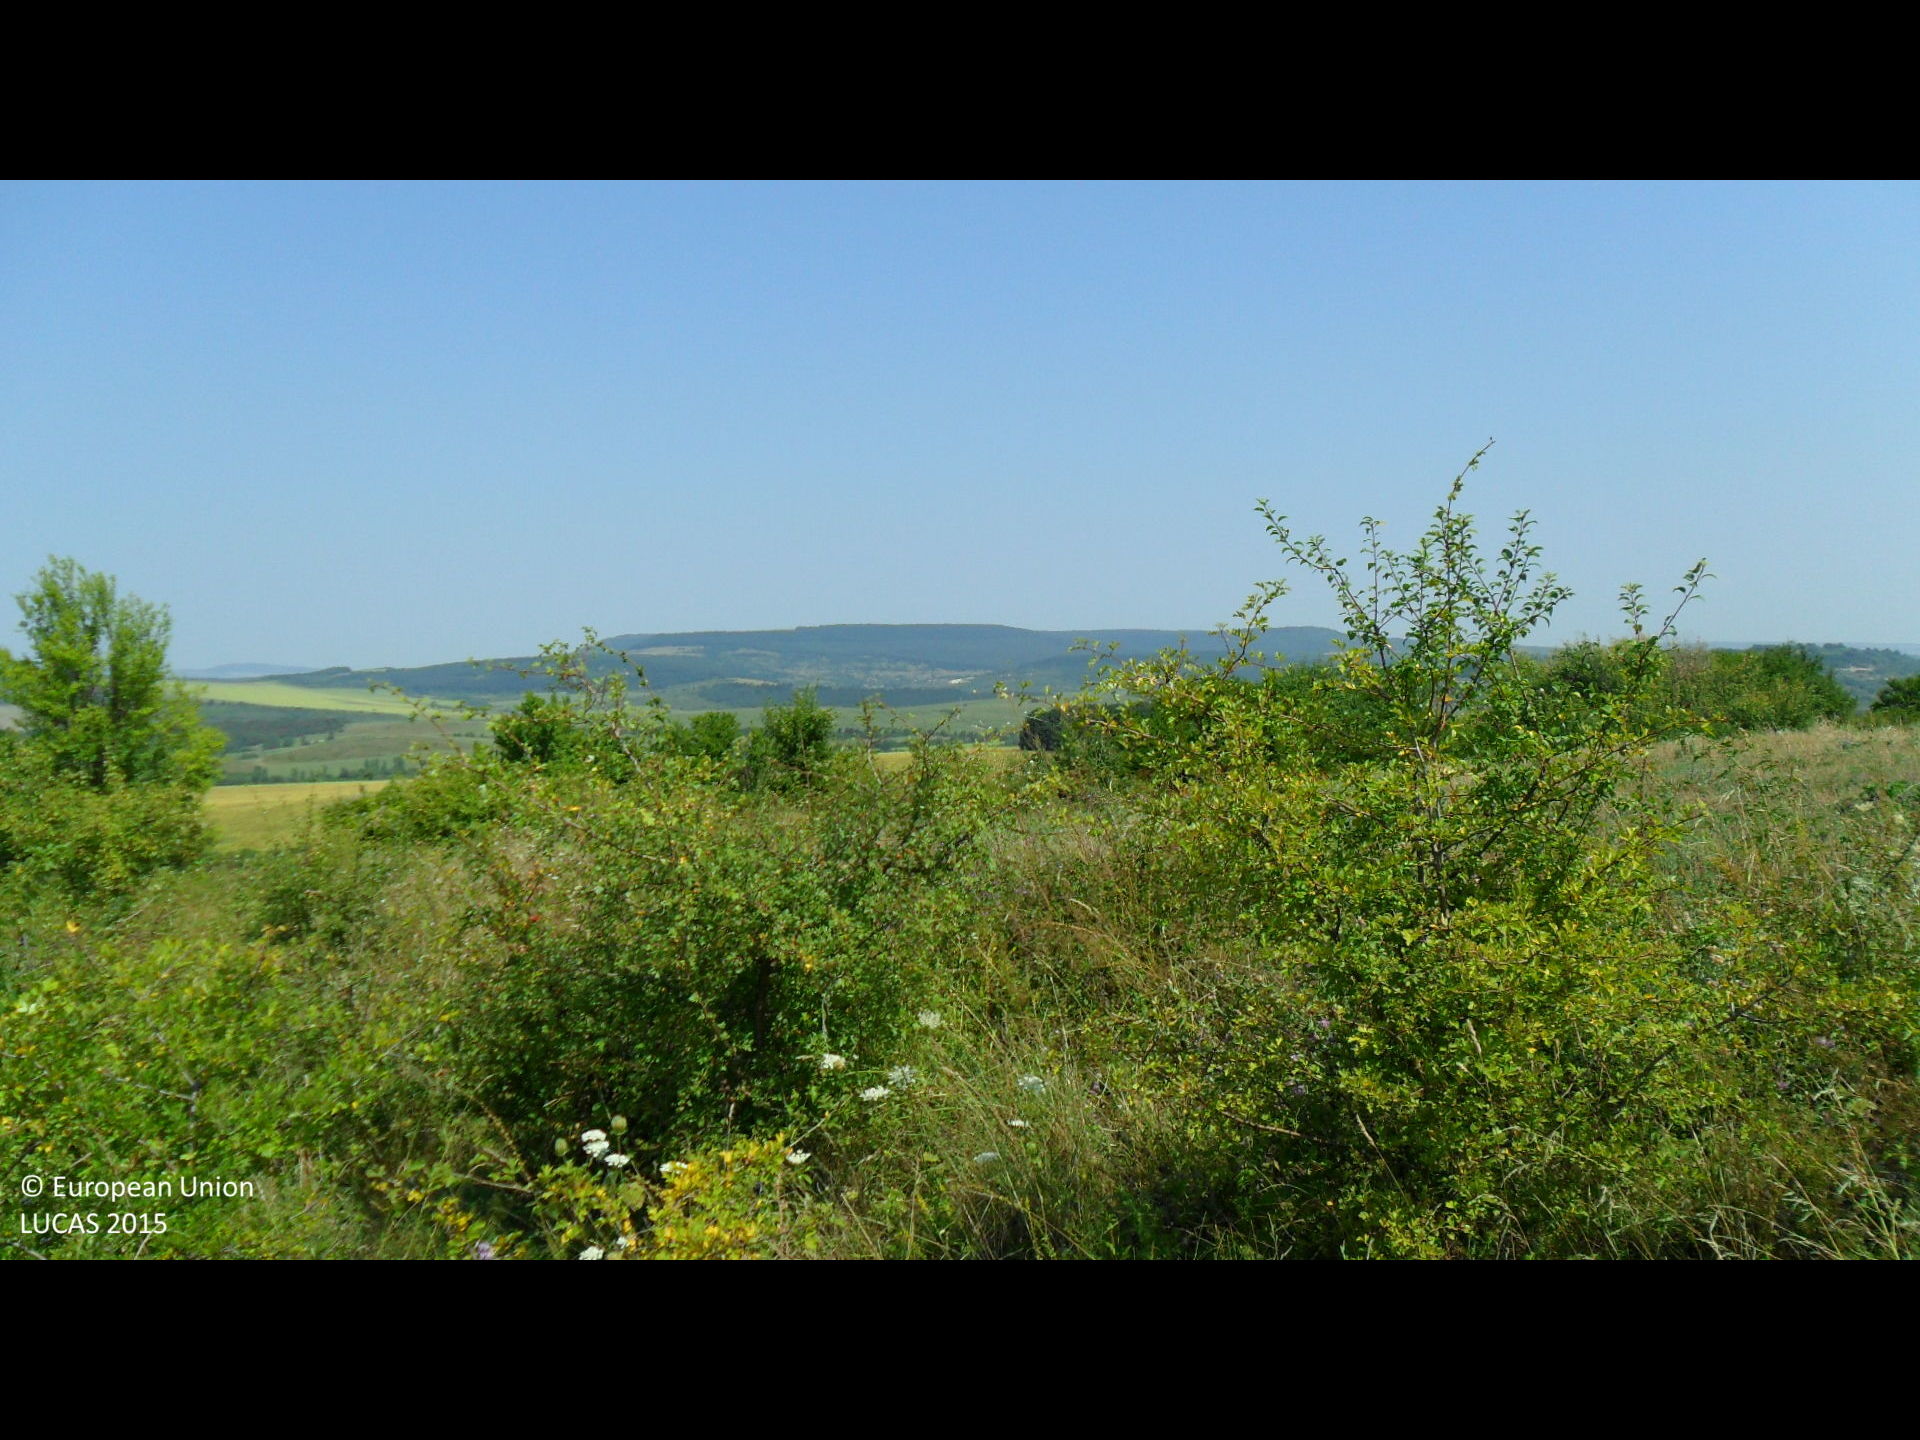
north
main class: Shrubland
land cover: Shrubland with sparse tree cover
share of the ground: > 75 %
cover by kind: shrubs 90 %, broadleaved forest trees 5 %, herbaceous plants 5 %
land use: Semi-natural and natural areas not in use
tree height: < 5 m
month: August
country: BG
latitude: 43.2854
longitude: 26.3285
